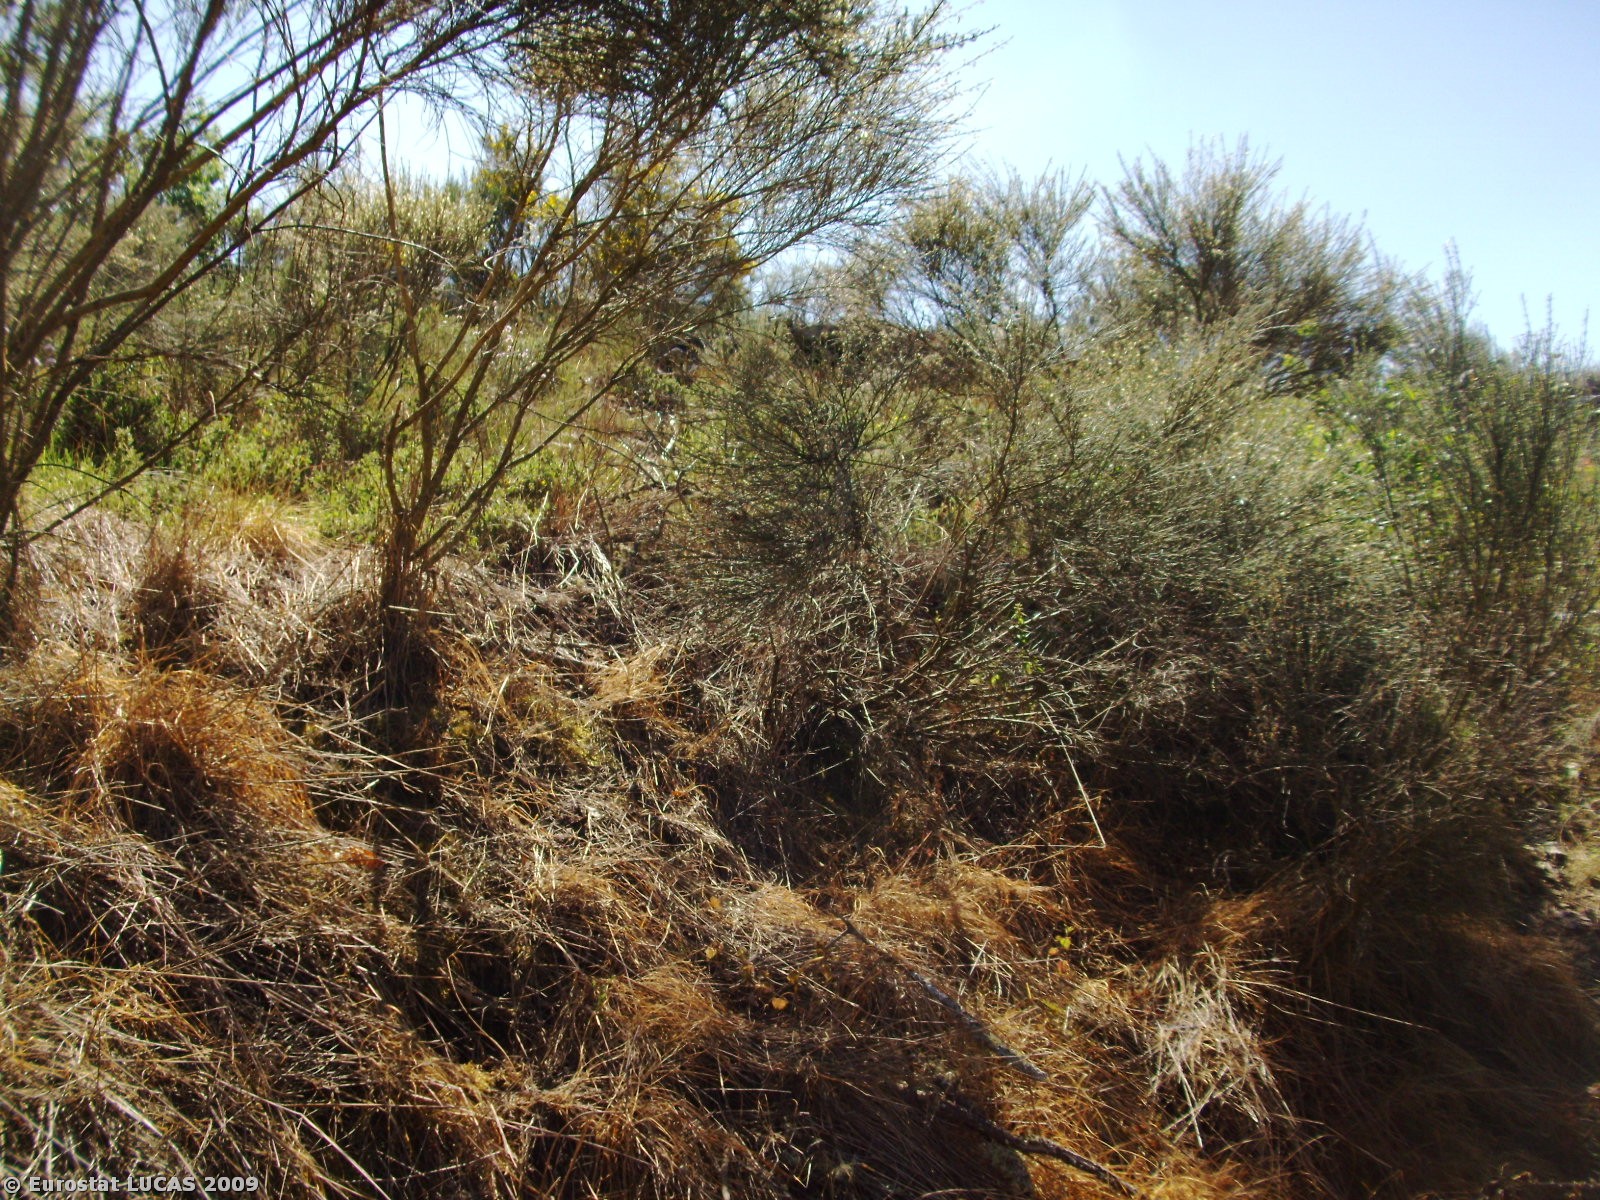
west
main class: Woodland
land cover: Mixed woodland
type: hemiboreal forest and nemoral coniferous forest and mixed broadleaved-coniferous forest
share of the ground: > 75 %
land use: Forestry
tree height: > 5 m
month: May
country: PT
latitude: 41.0827
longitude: -7.5851
